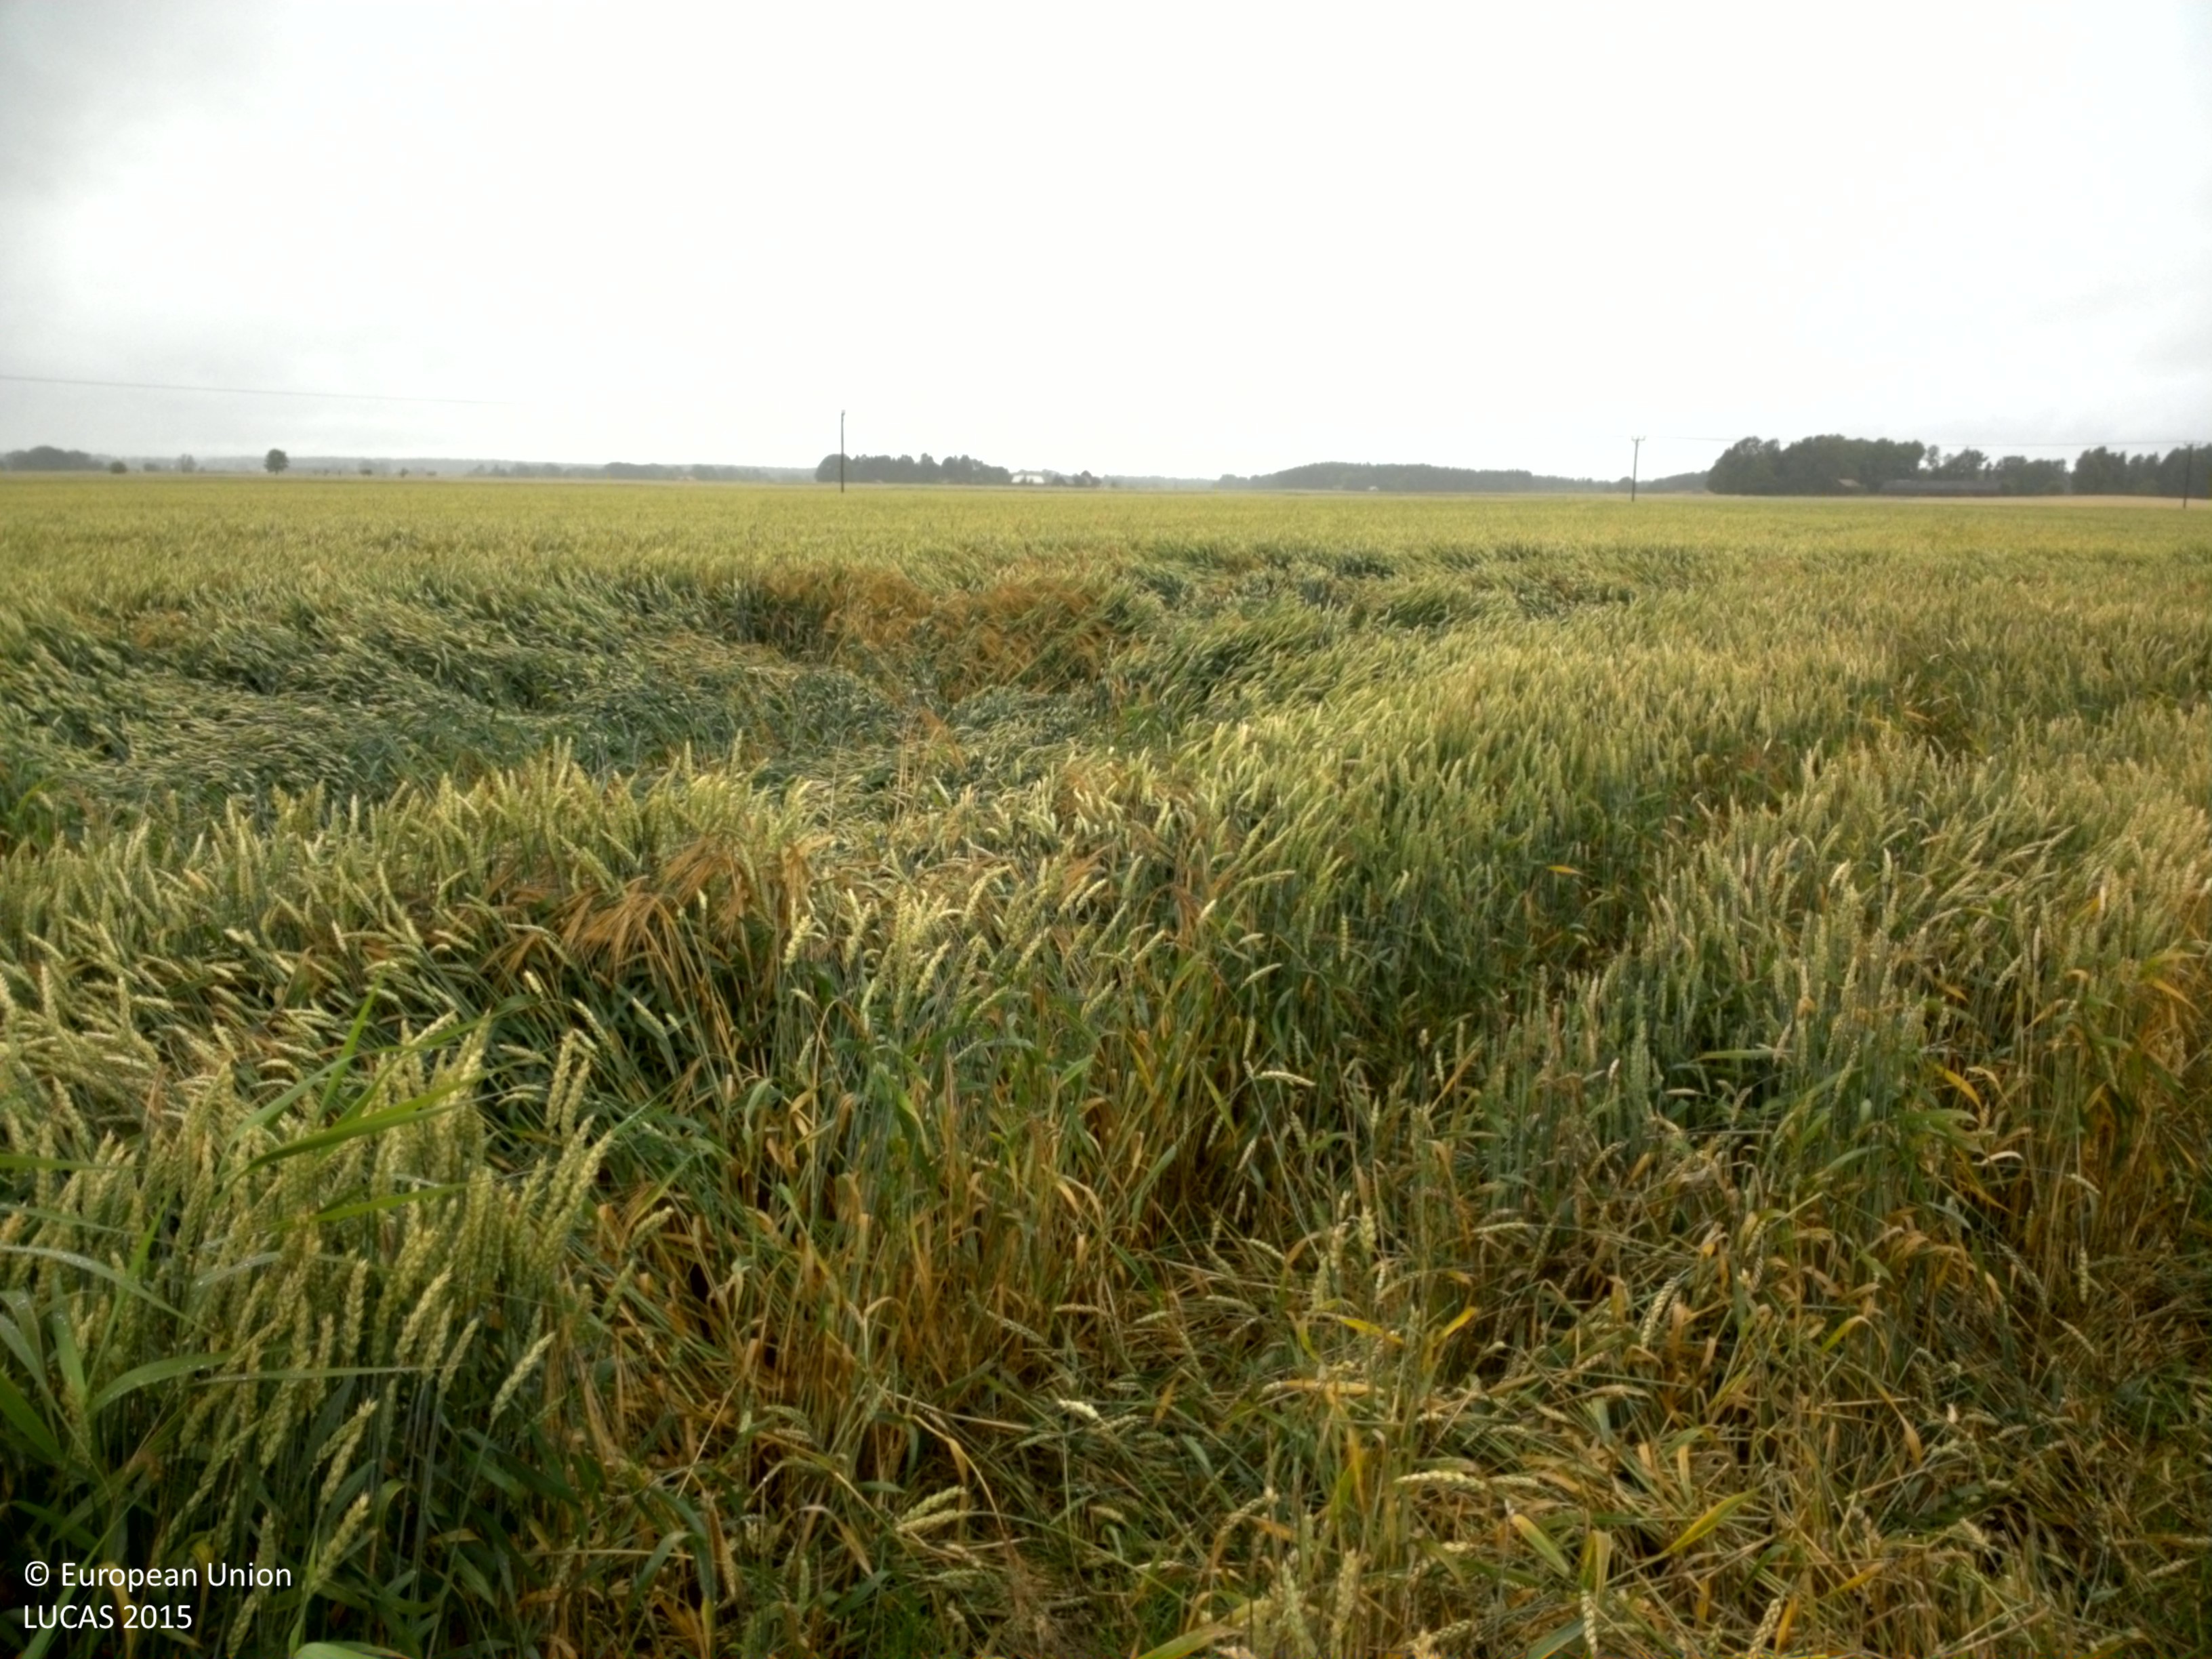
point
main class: Cropland
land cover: Common wheat
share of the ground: > 75 %
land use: Agriculture (excluding fallow land and kitchen gardens)
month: July
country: SE
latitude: 58.4678
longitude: 13.2685
